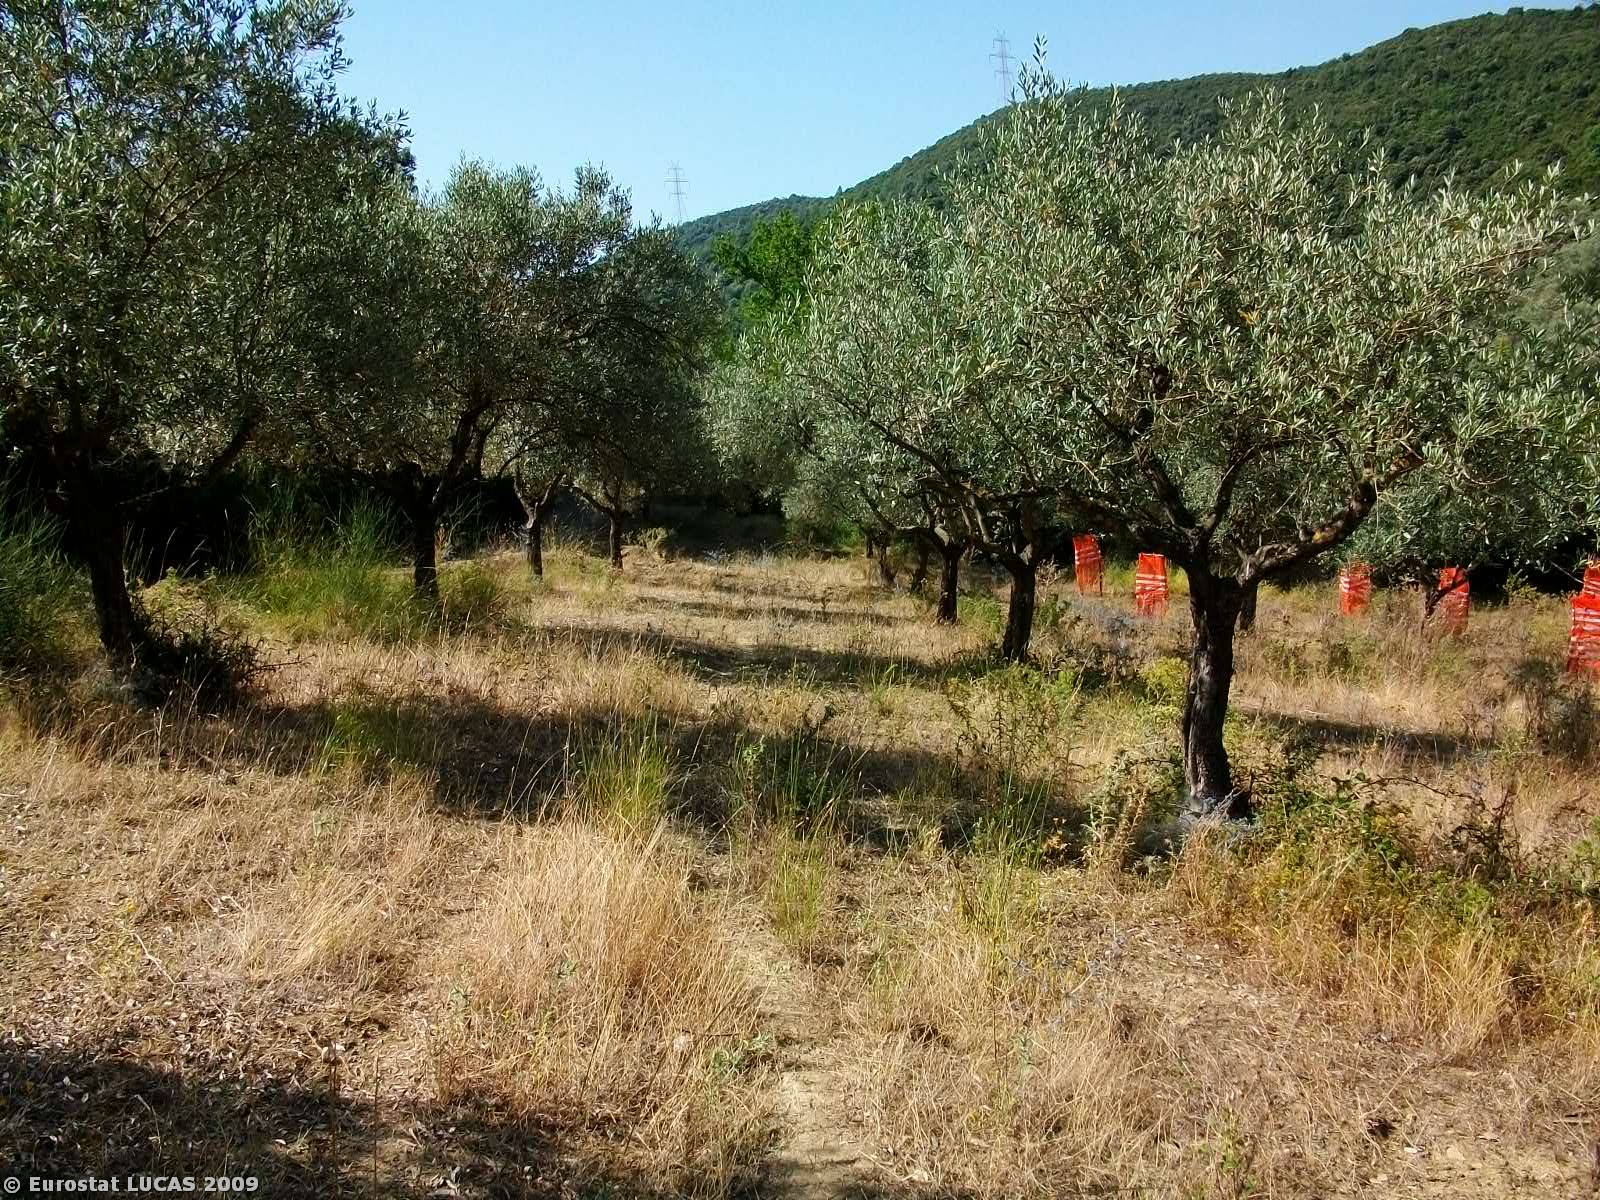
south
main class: Woodland
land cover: Broadleaved woodland
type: broadleaved evergreen forest
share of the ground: > 75 %
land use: Forestry
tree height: > 5 m
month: July
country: GR
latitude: 38.6422
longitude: 21.4711
